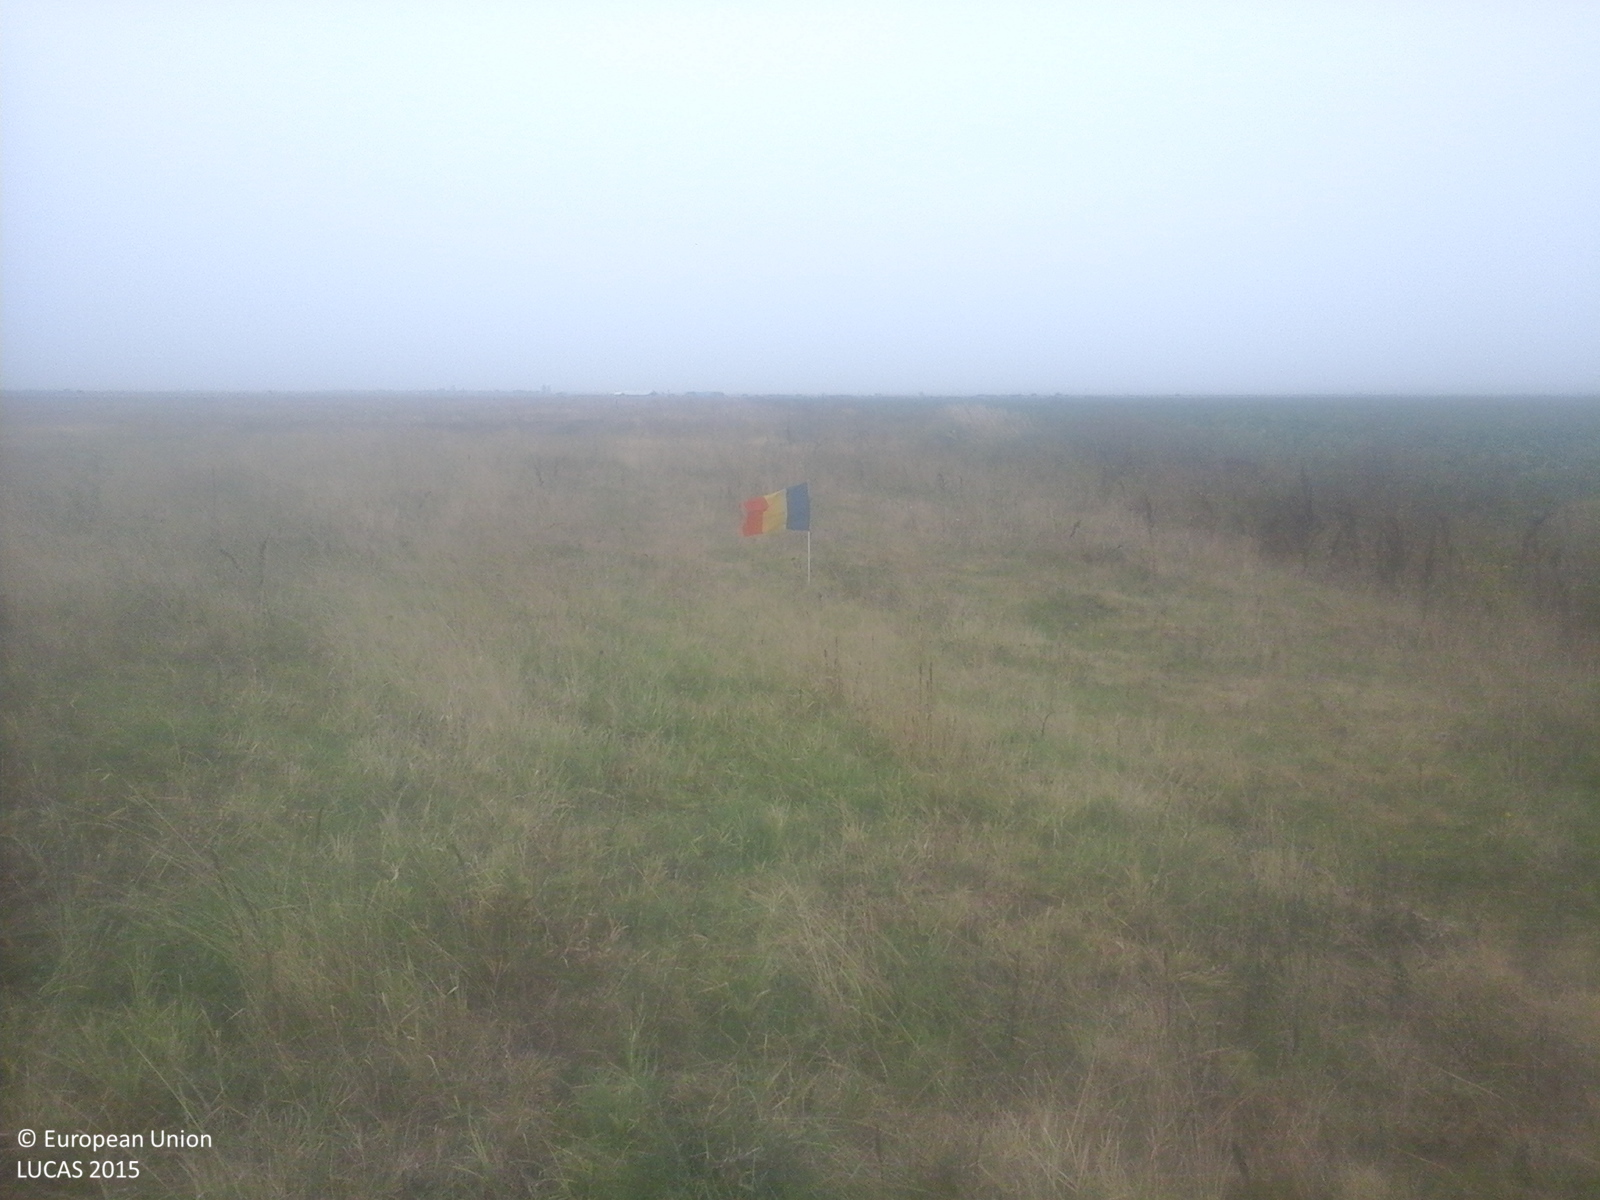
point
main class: Grassland
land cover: Grassland without tree/shrub cover
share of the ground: > 75 %
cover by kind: herbaceous plants 100 %
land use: Agriculture (excluding fallow land and kitchen gardens)
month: September
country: RO
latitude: 47.5414
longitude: 22.5329
